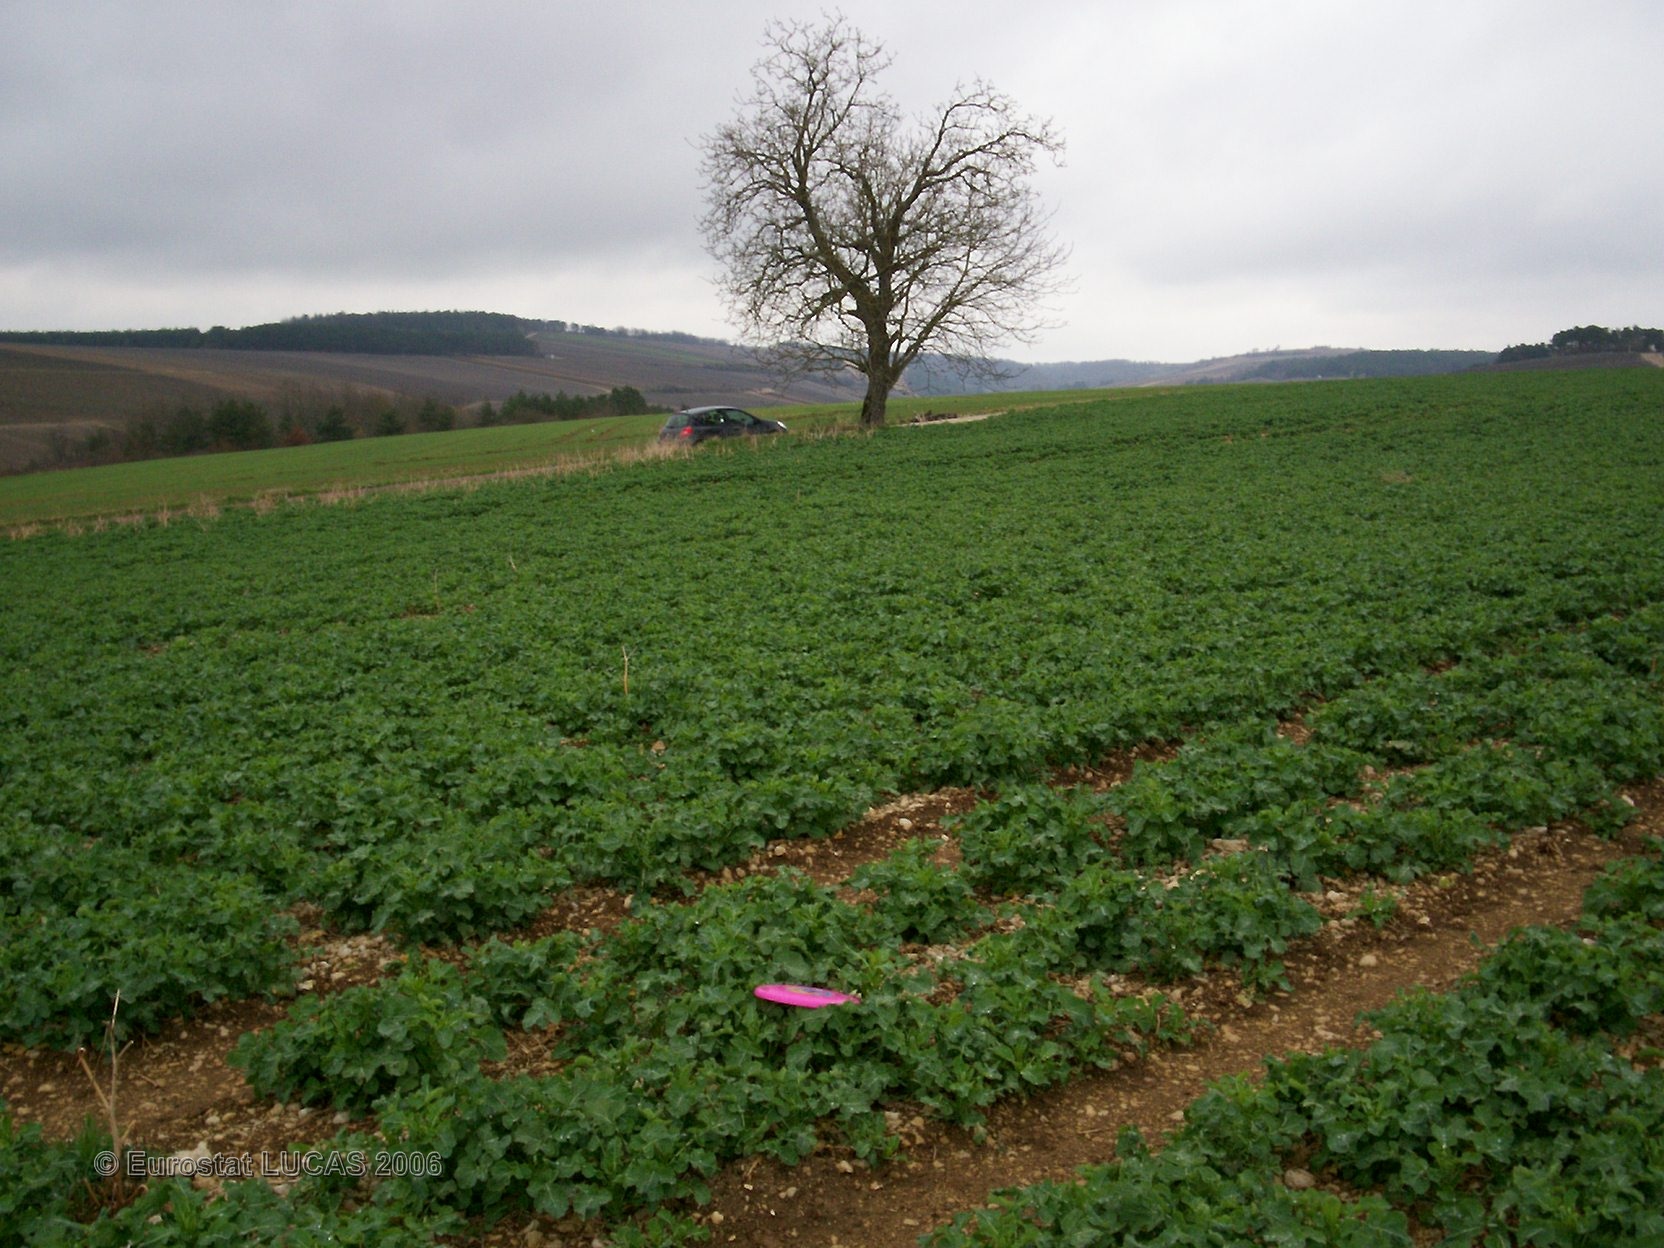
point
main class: Cropland
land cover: Rape and turnip rape
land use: Agriculture (excluding fallow land and kitchen gardens)
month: April
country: FR
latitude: 48.0687
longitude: 4.5090
